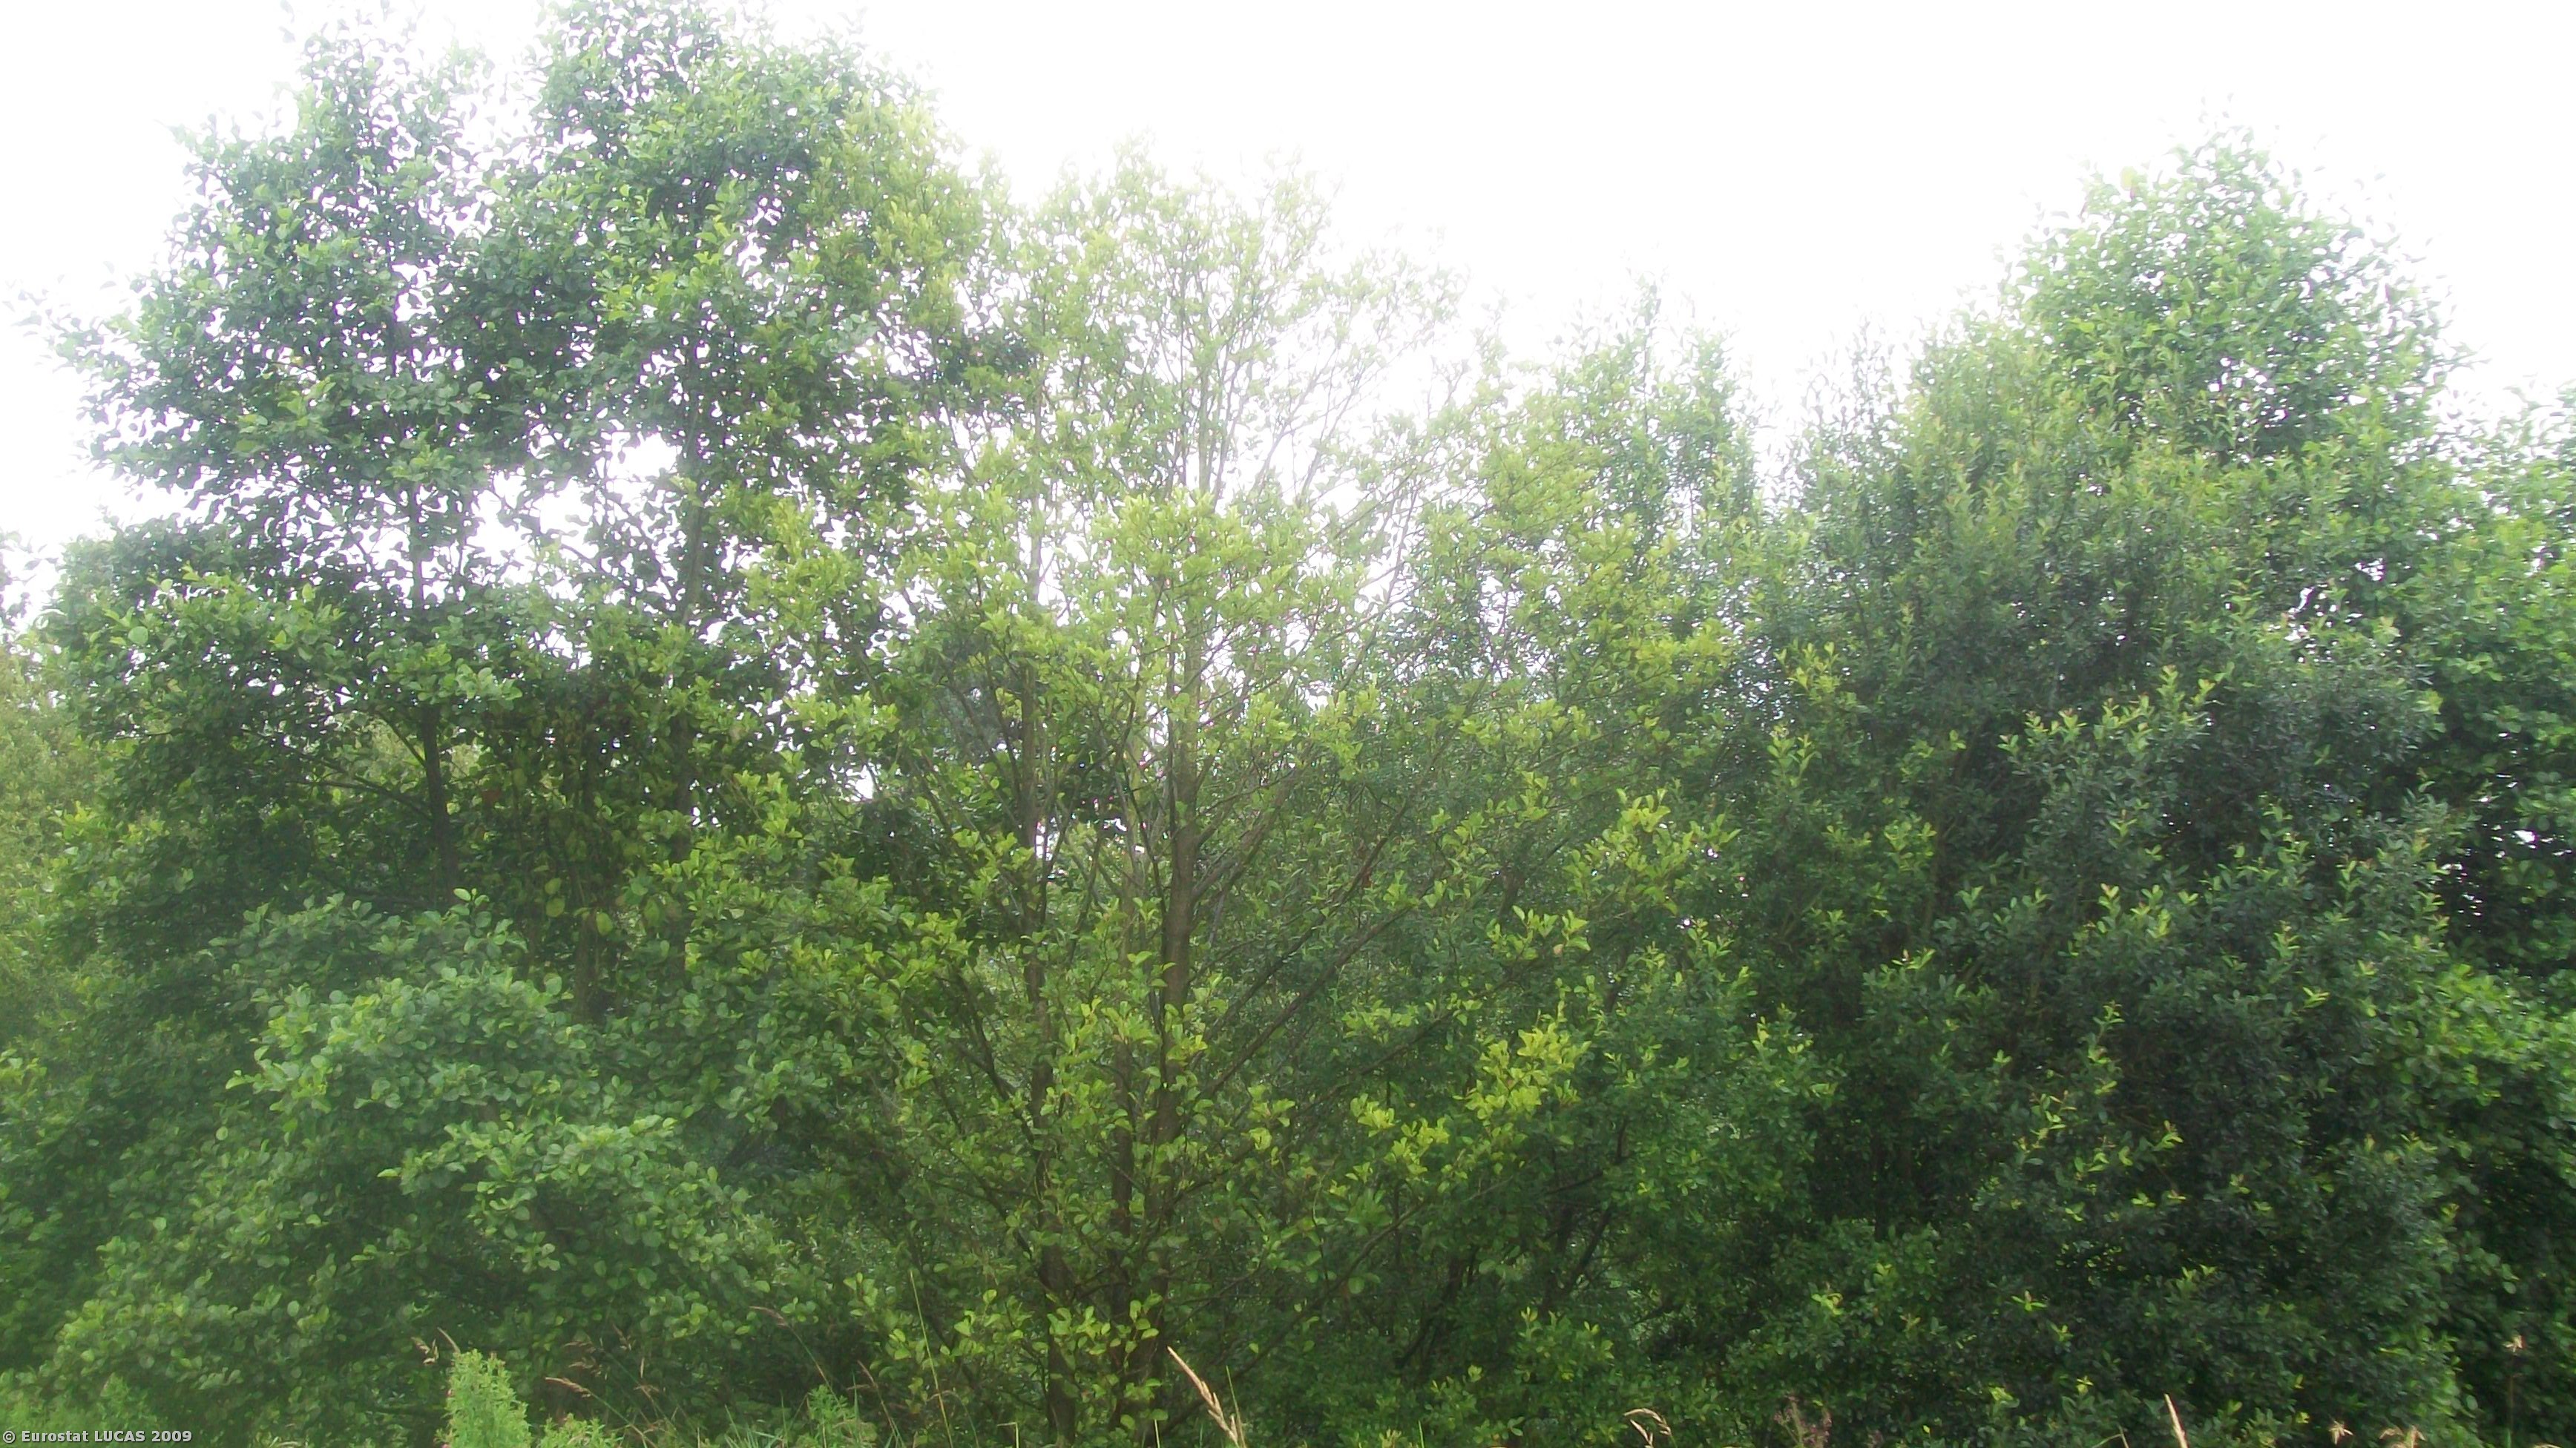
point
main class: Woodland
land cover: Broadleaved woodland
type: non-riverine alder, birch or aspen forest
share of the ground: > 75 %
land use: Unused
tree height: > 5 m
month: July
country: GB
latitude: 53.0070
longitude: -2.6617
